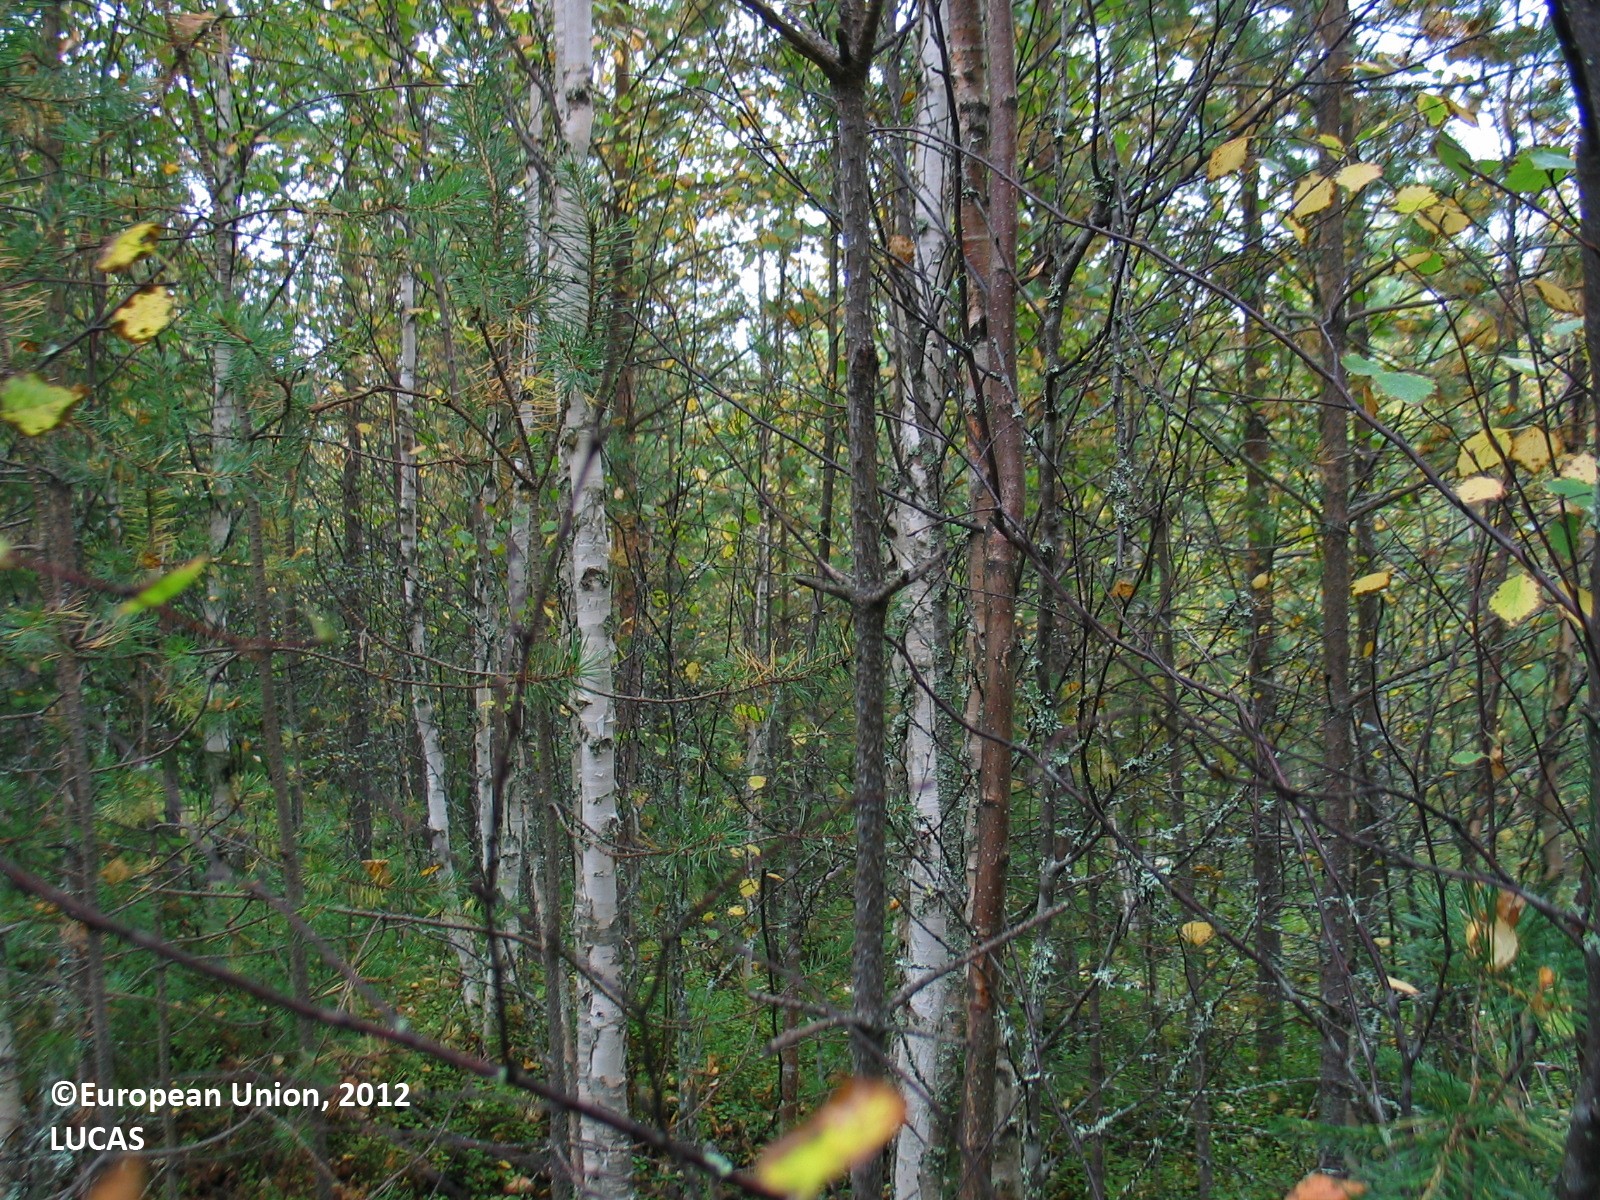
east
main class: Woodland
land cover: Pine dominated mixed woodland
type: boreal forest
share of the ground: 50 - 75 %
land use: Forestry
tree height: > 5 m
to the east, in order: Pine dominated mixed woodland; Broadleaved woodland; Spruce dominated coniferous woodland; Broadleaved woodland; Inland marshes; Ditches and canals; Inland marshes; Broadleaved woodland
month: September
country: FI
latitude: 65.2166
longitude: 25.5396
